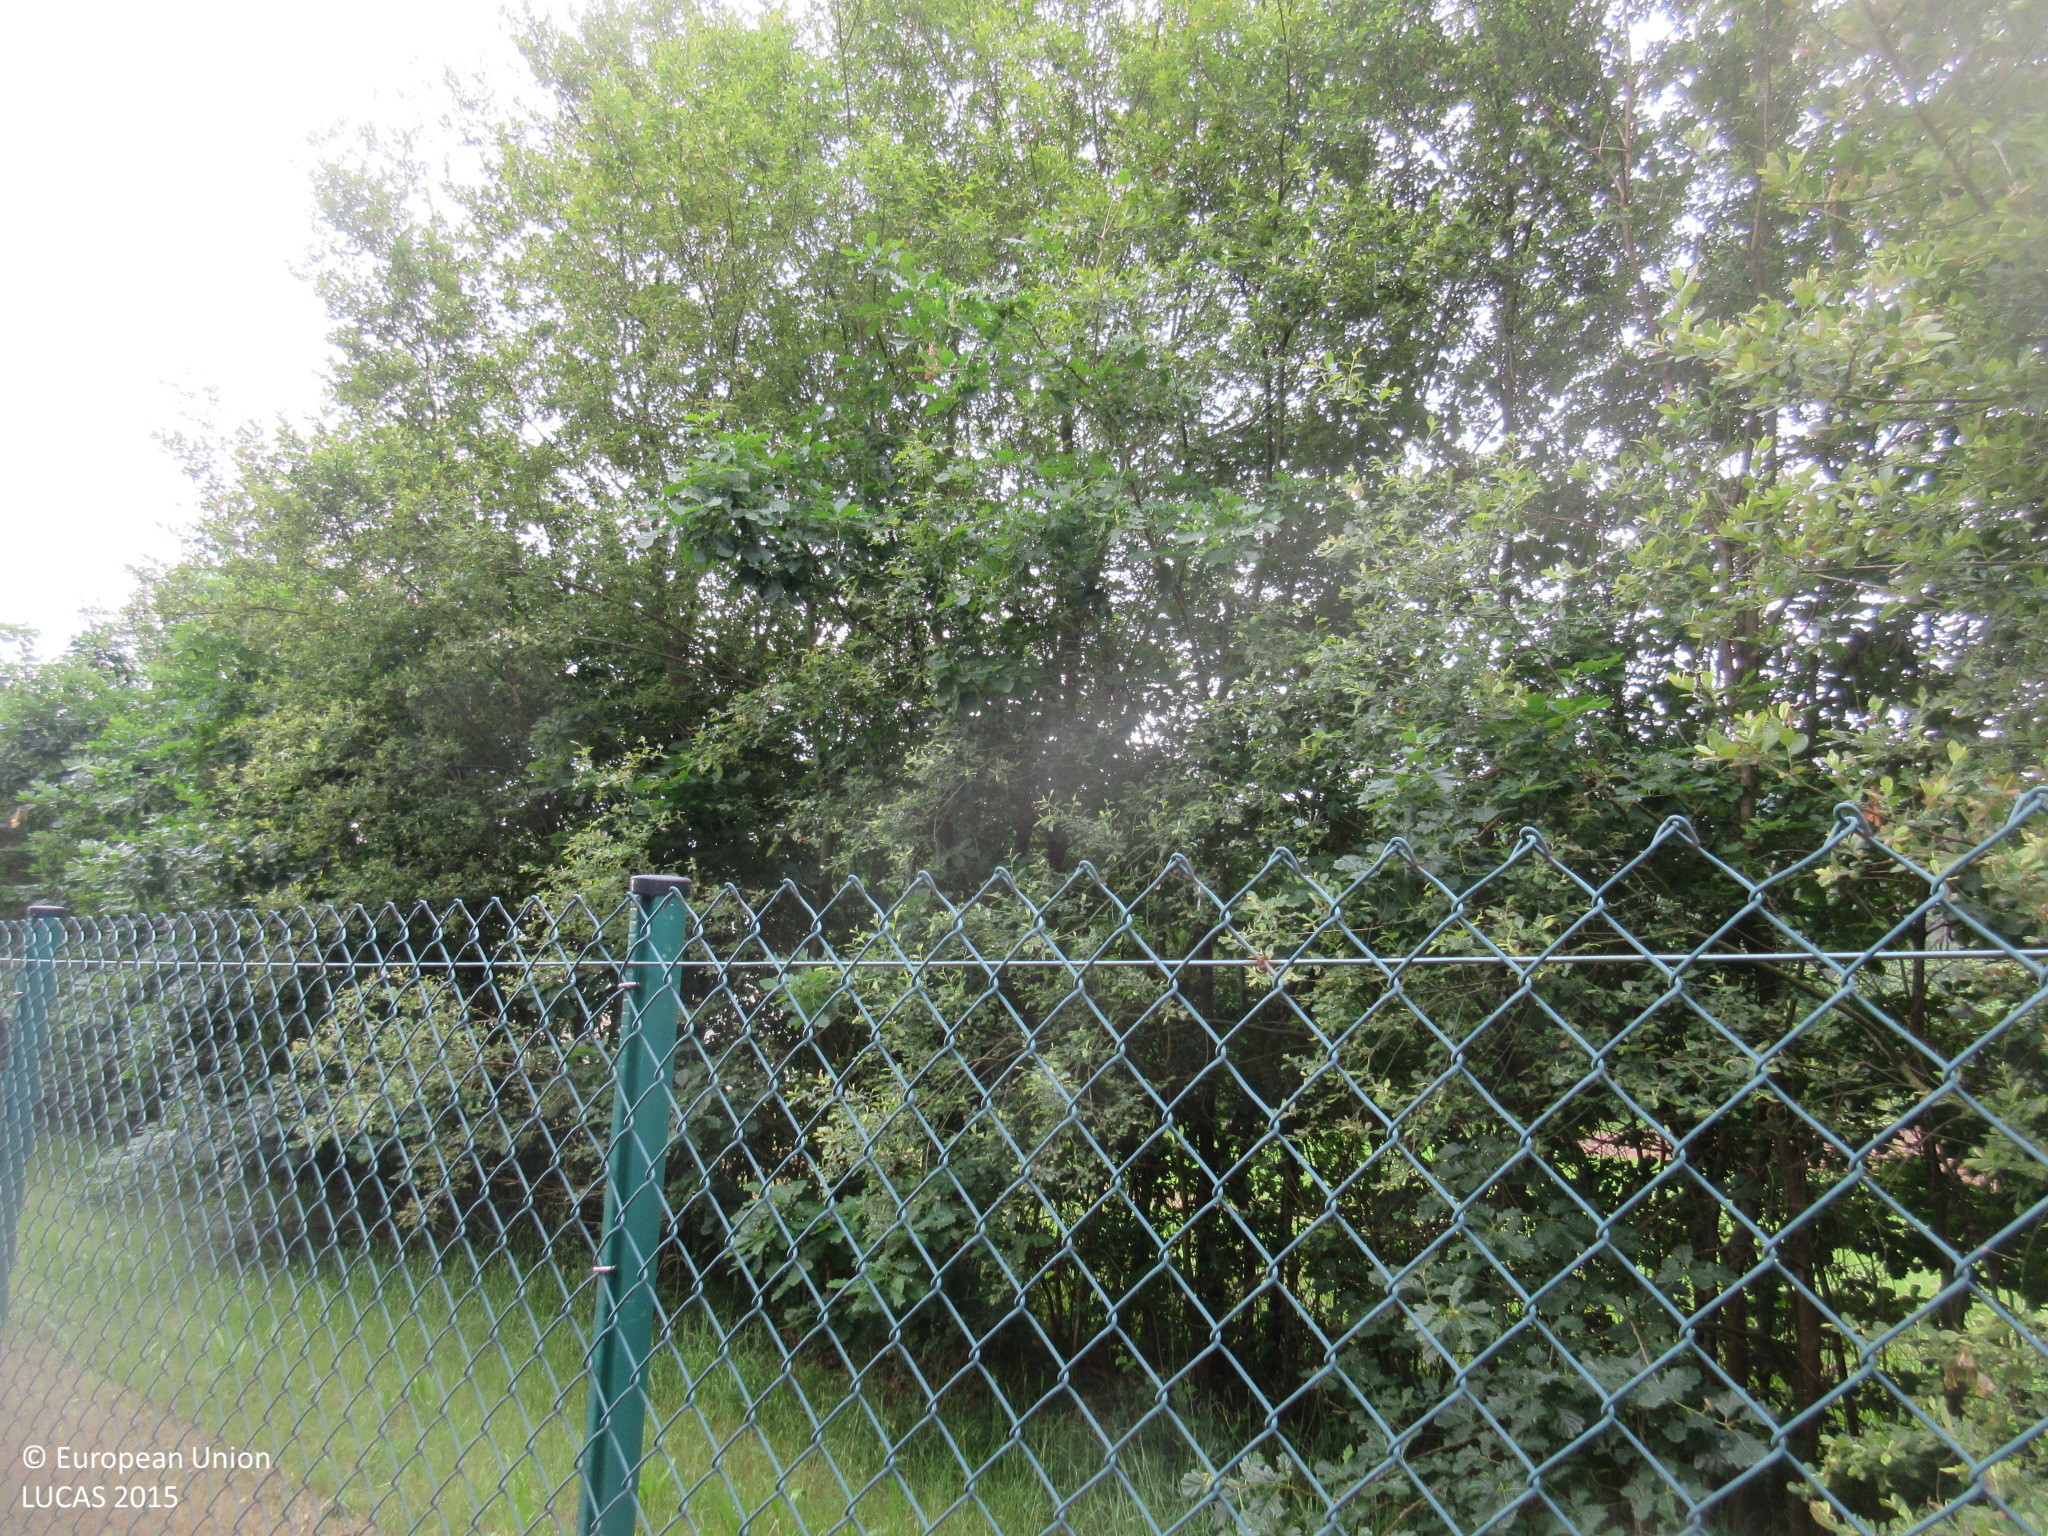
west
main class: Grassland
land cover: Grassland without tree/shrub cover
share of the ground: > 75 %
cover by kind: herbaceous plants 100 %
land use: Agriculture (excluding fallow land and kitchen gardens)
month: June
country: ES
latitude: 43.3594
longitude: -4.1323
